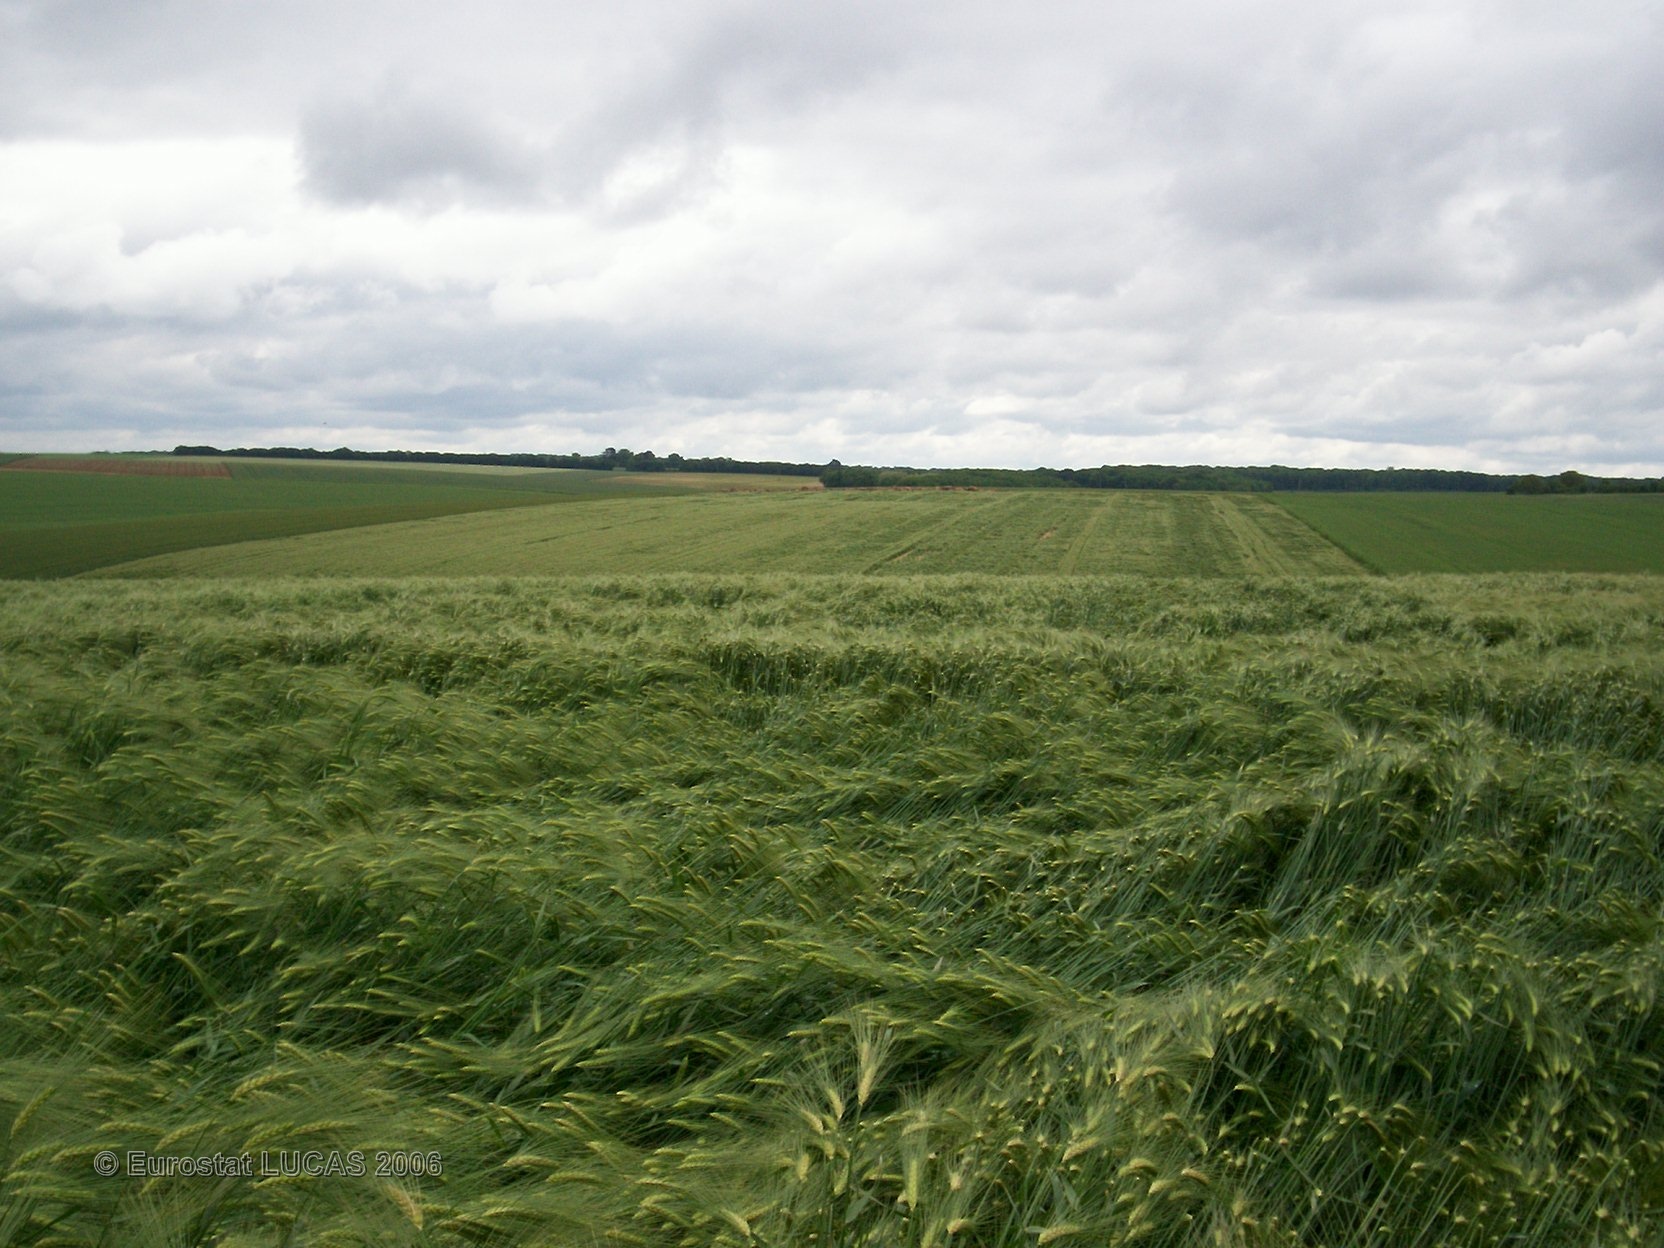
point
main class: Cropland
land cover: Barley
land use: Agriculture (excluding fallow land and kitchen gardens)
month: May
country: FR
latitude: 48.2149
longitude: 4.5471
